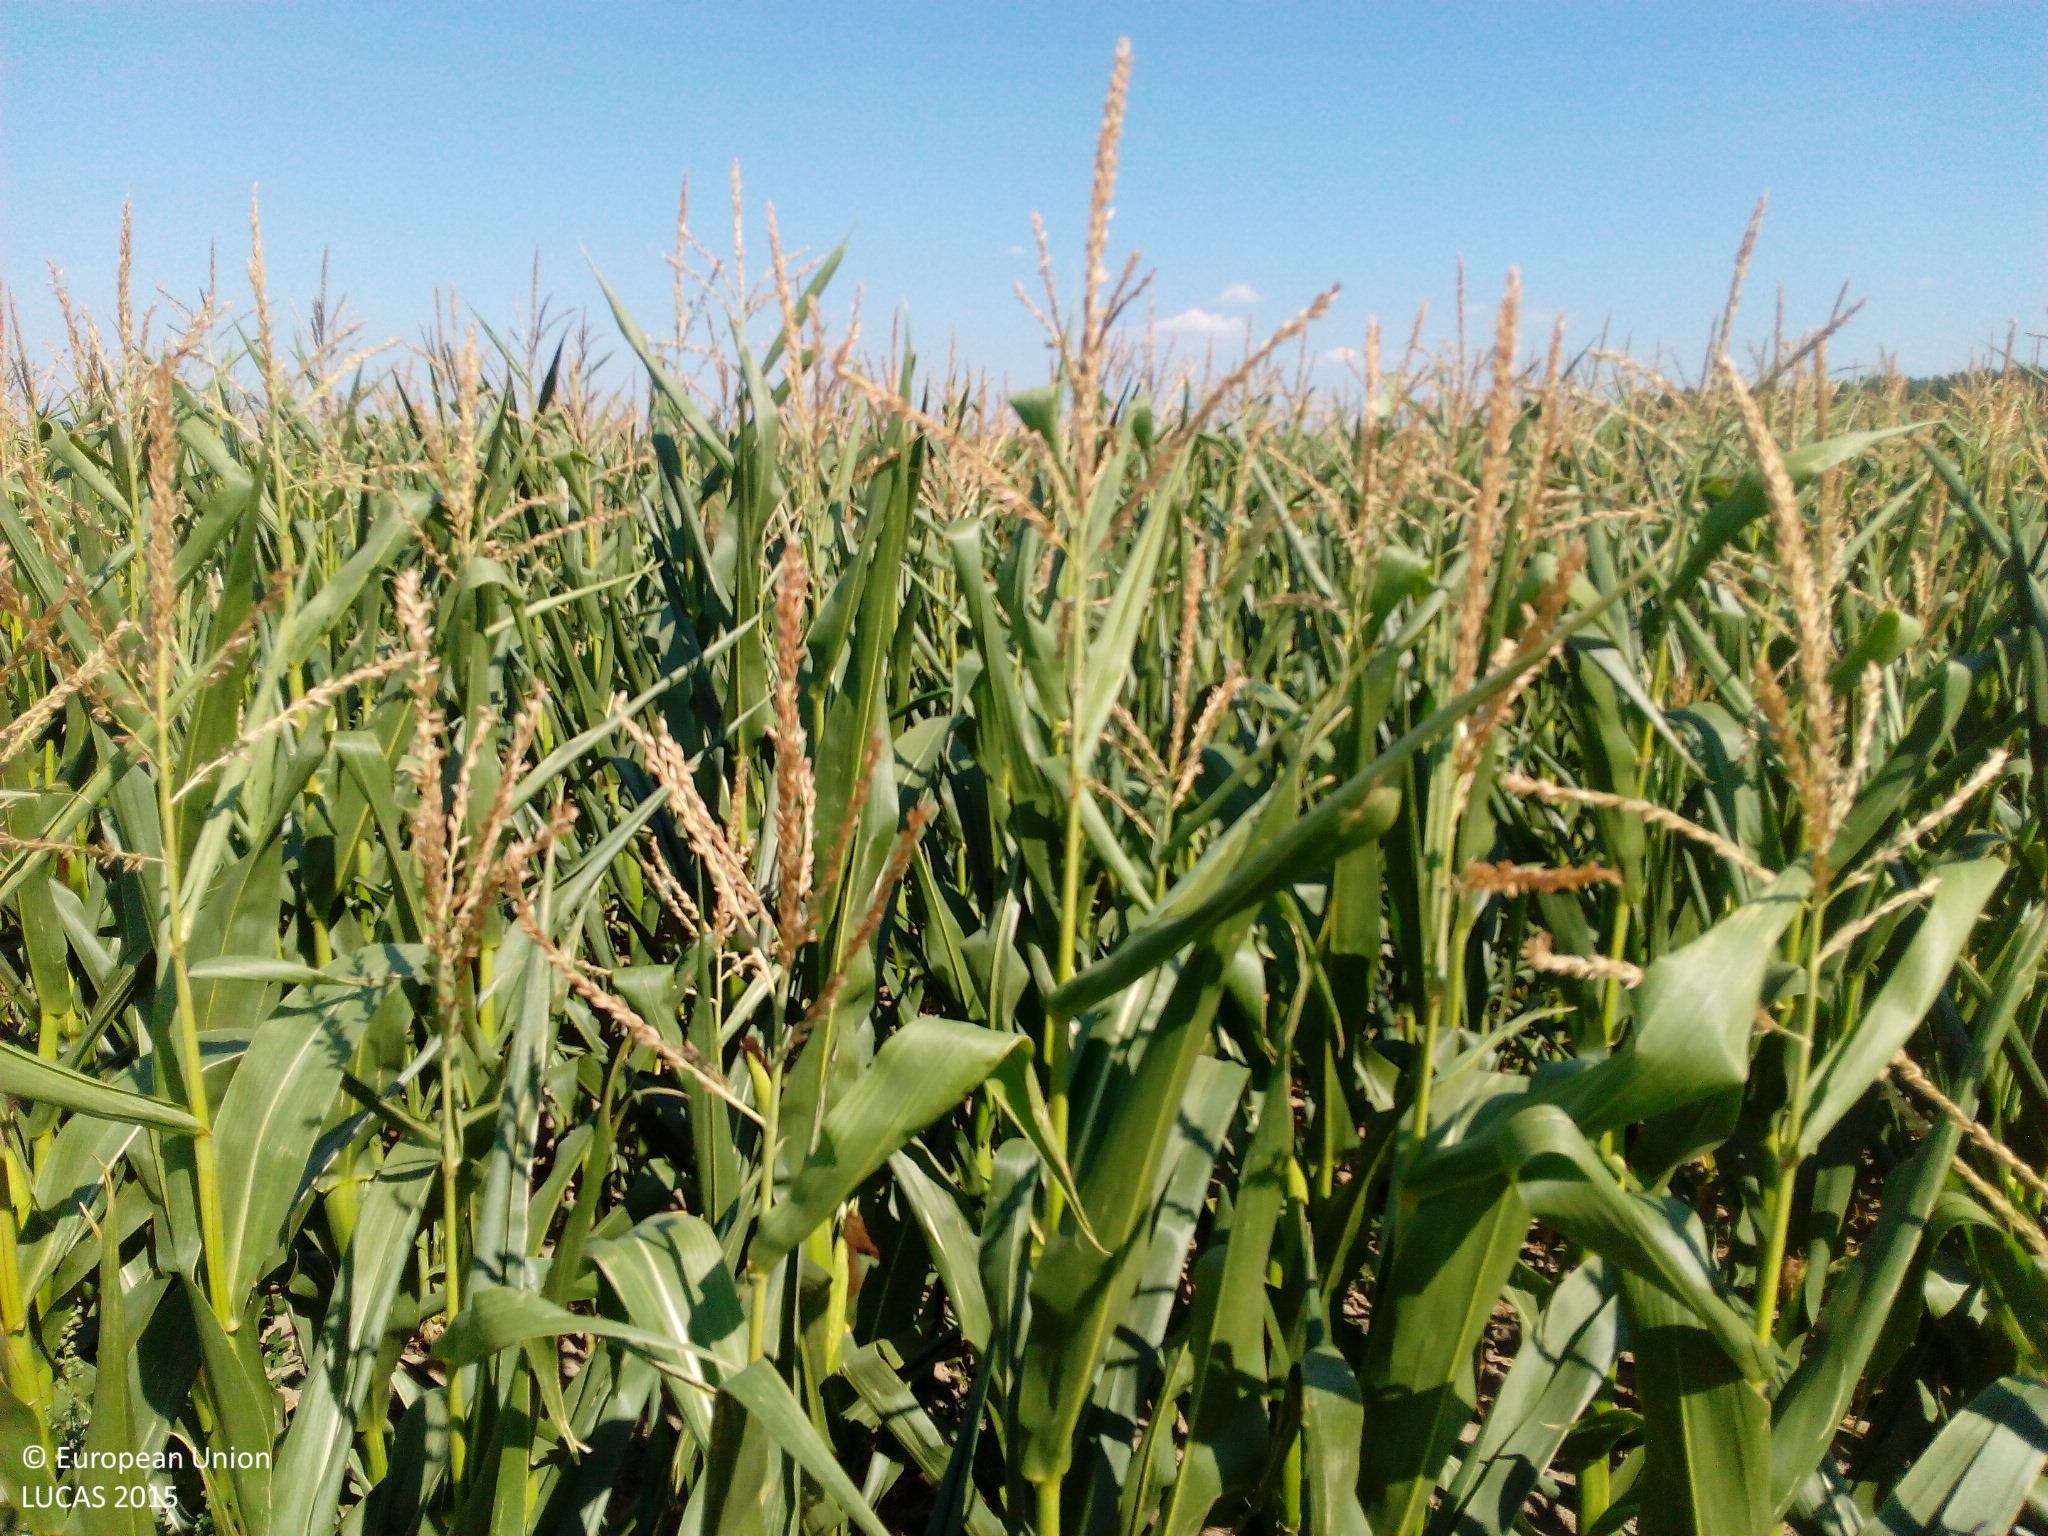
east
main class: Cropland
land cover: Maize
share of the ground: > 75 %
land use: Agriculture (excluding fallow land and kitchen gardens)
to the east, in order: Maize
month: August
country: DE
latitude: 51.9944
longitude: 13.1313
